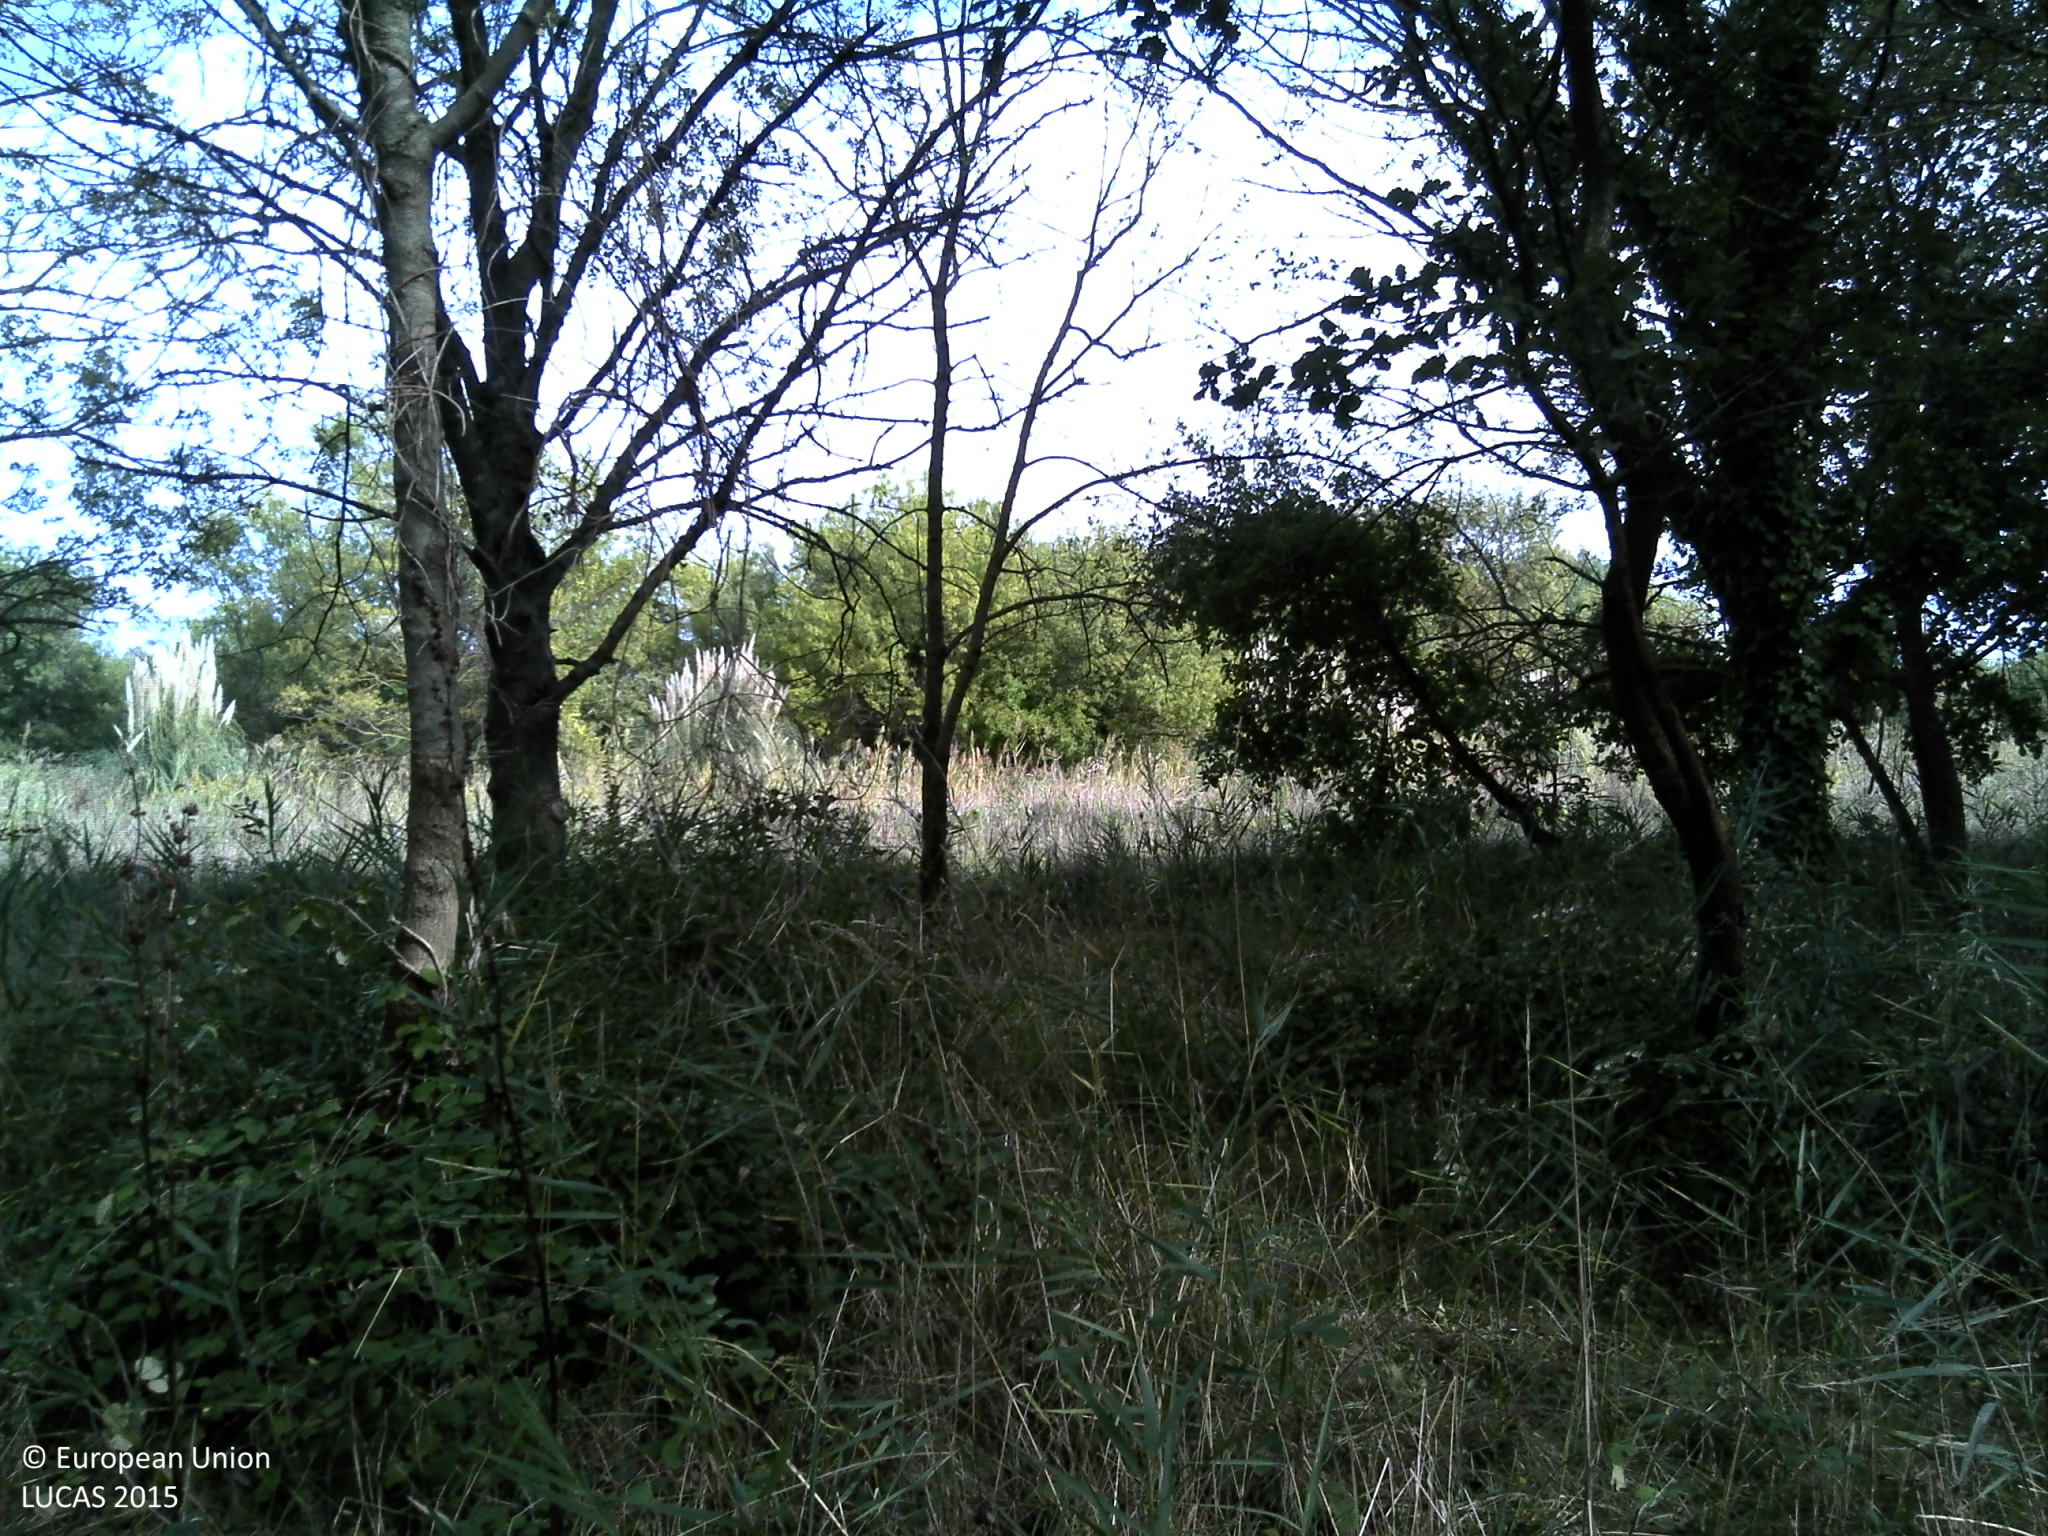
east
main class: Woodland
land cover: Broadleaved woodland
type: thermophilous deciduous forest
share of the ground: > 75 %
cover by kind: broadleaved forest trees 70 %, herbaceous plants 20 %, unconsolidated bare surface 10 %
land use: Abandoned areas
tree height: > 5 m
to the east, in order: Broadleaved woodland; Grassland without tree/shrub cover; Tracks; Broadleaved woodland; Artificial constructions in urban areas; Grassland without tree/shrub cover
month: October
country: FR
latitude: 43.2646
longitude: 6.5717
